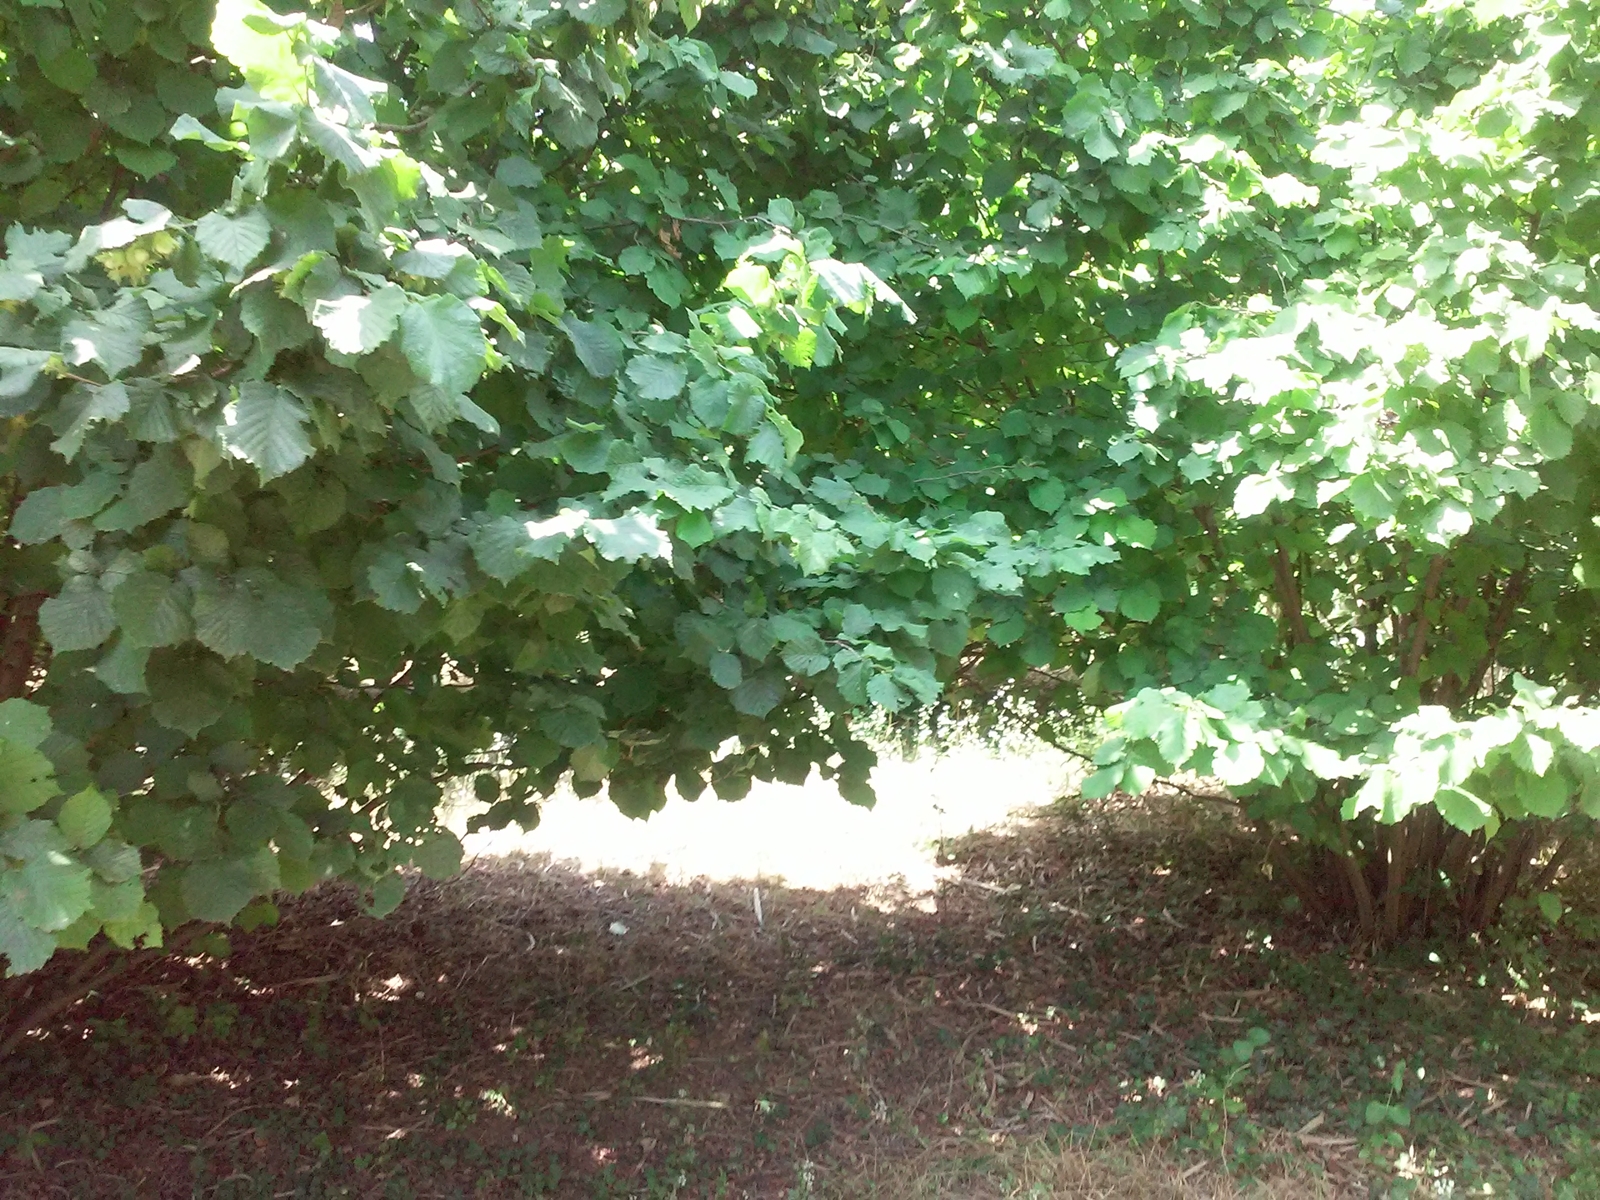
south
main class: Cropland
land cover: Nuts trees
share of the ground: > 75 %
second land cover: Grassland without tree/shrub cover
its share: > 75 %
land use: Agriculture (excluding fallow land and kitchen gardens)
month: June
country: ES
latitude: 41.2750
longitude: 1.2420
